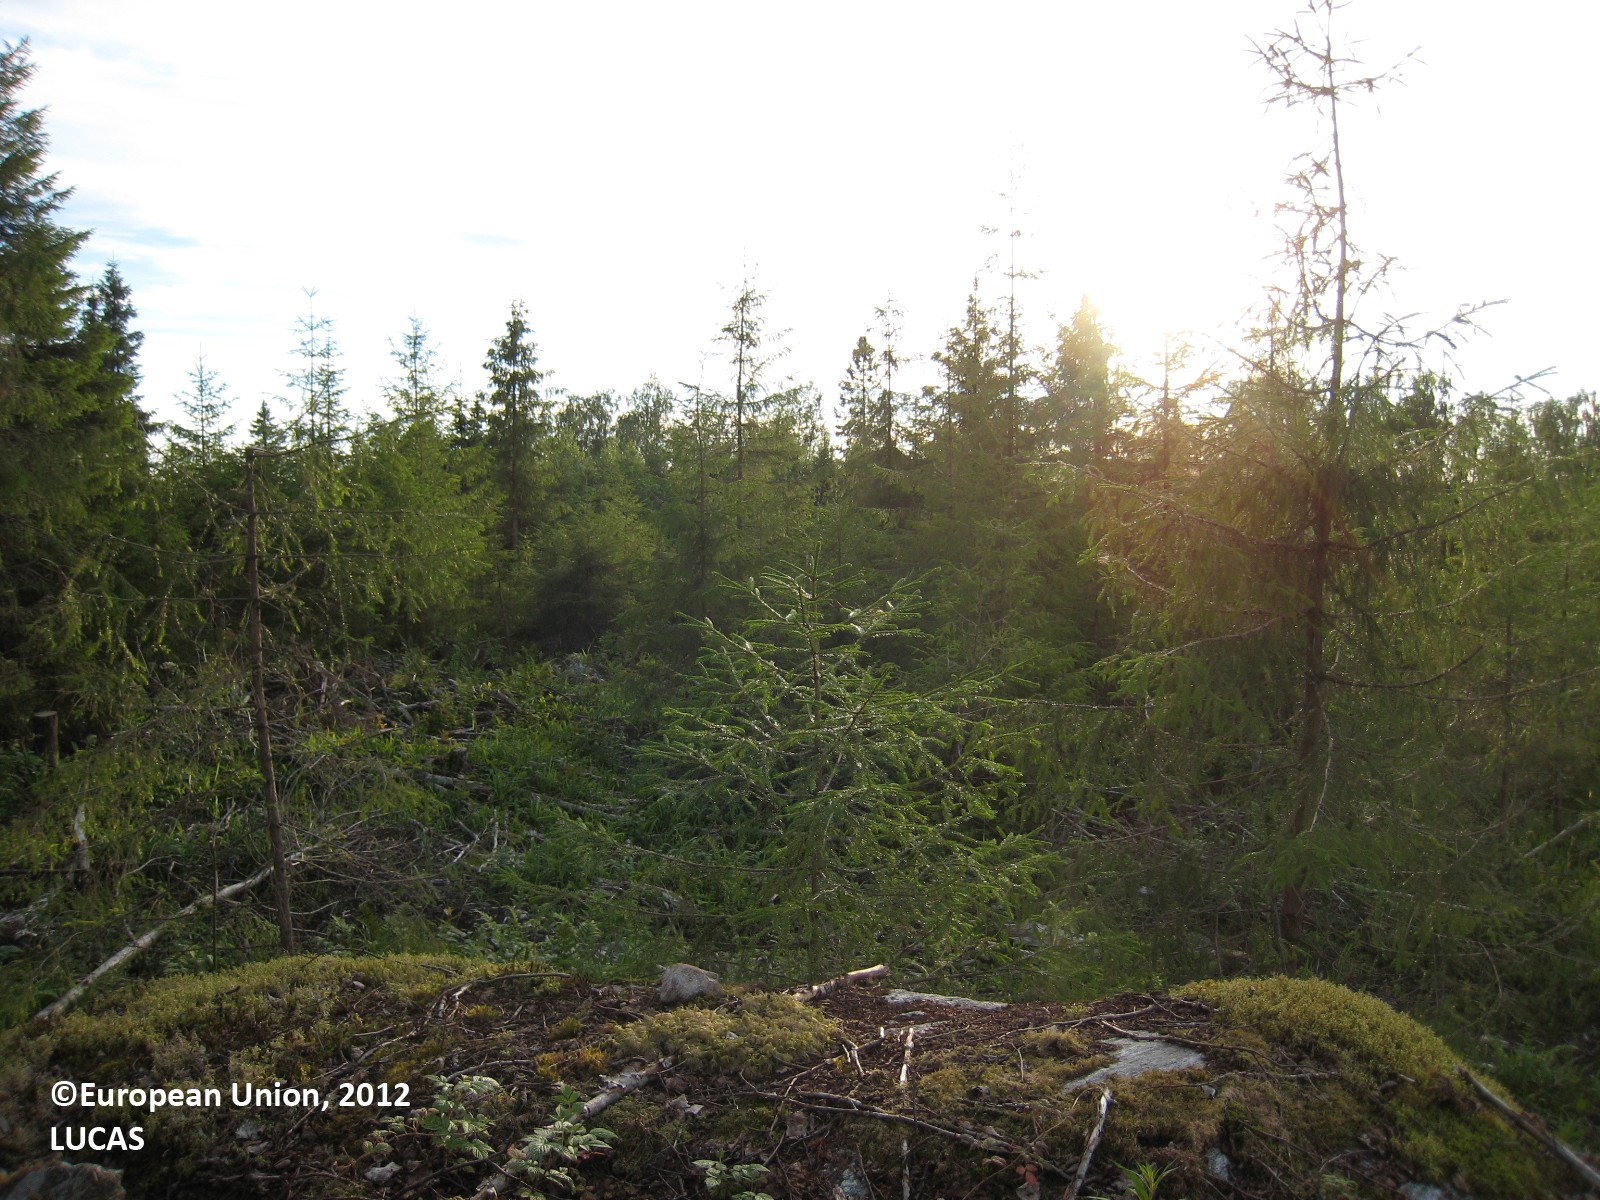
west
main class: Woodland
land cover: Spruce dominated coniferous woodland
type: boreal forest
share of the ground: 25 - 50 %
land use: Forestry
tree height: > 5 m
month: July
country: FI
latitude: 63.1636
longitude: 26.9195
